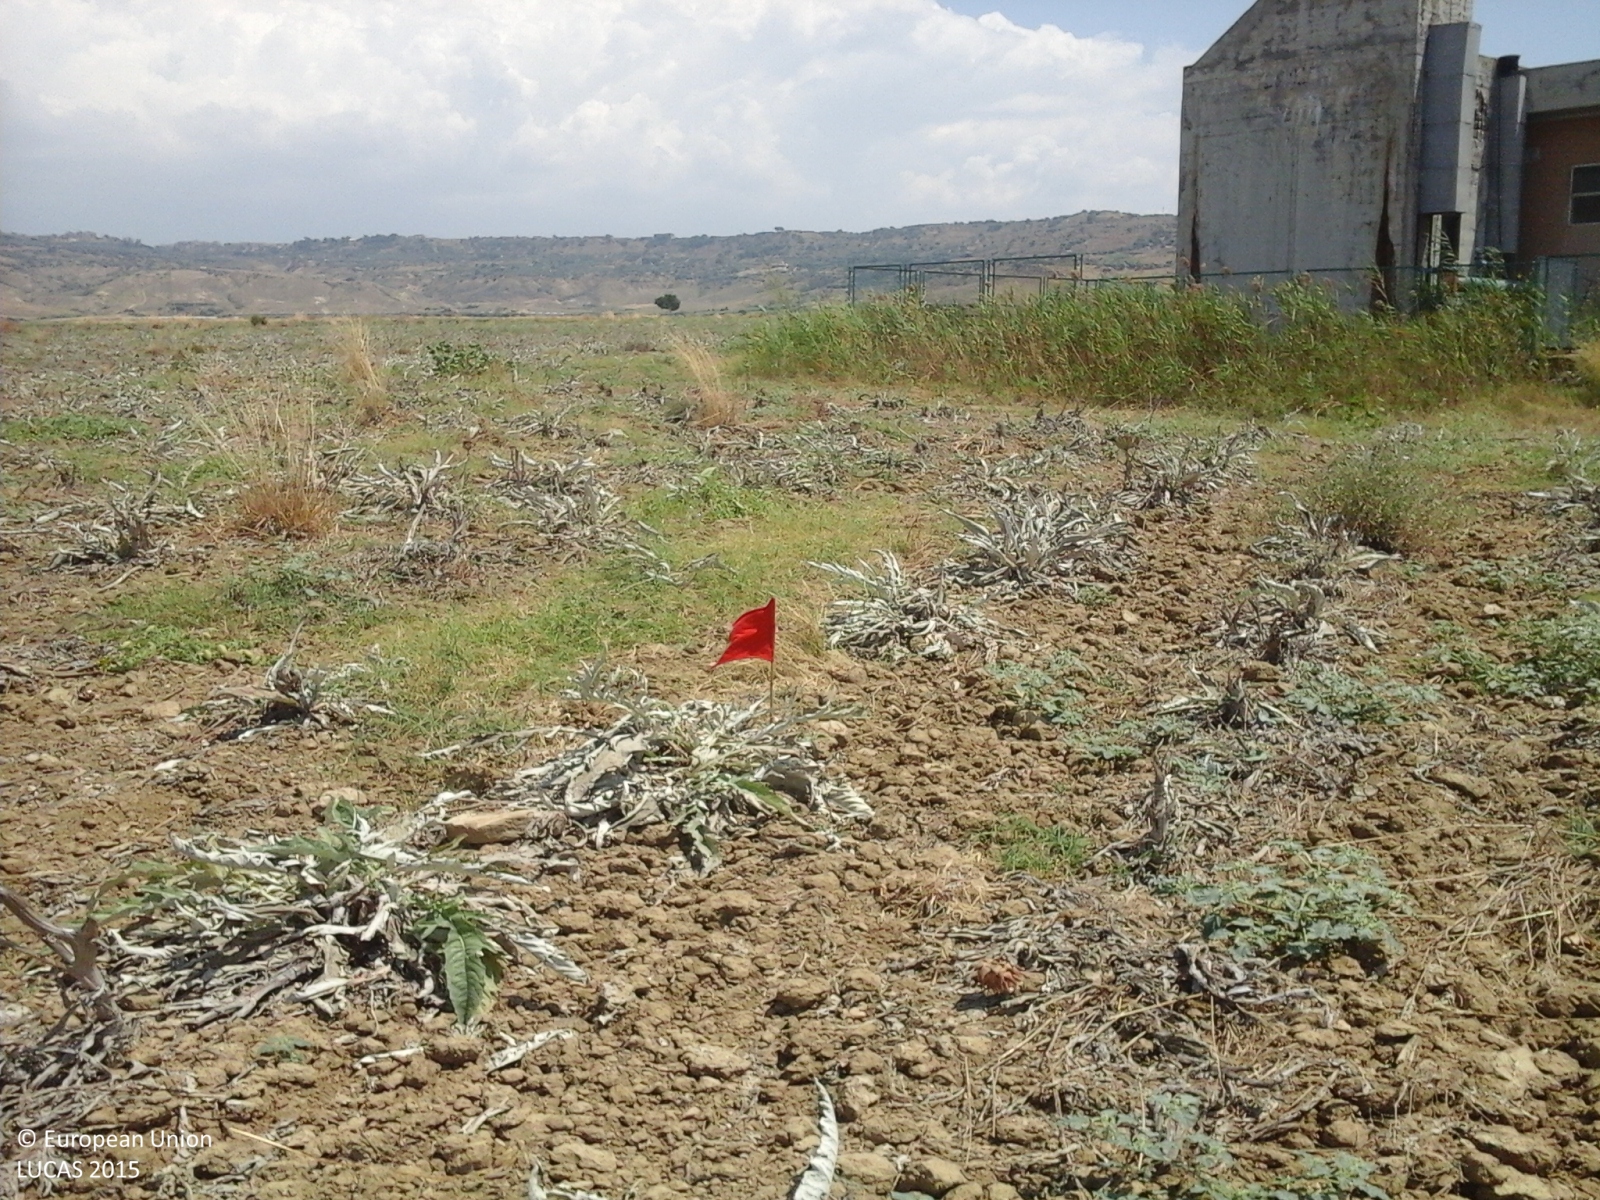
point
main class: Cropland
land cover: Other fresh vegetables
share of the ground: > 75 %
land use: Agriculture (excluding fallow land and kitchen gardens)
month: July
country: IT
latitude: 37.1200
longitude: 14.3665
